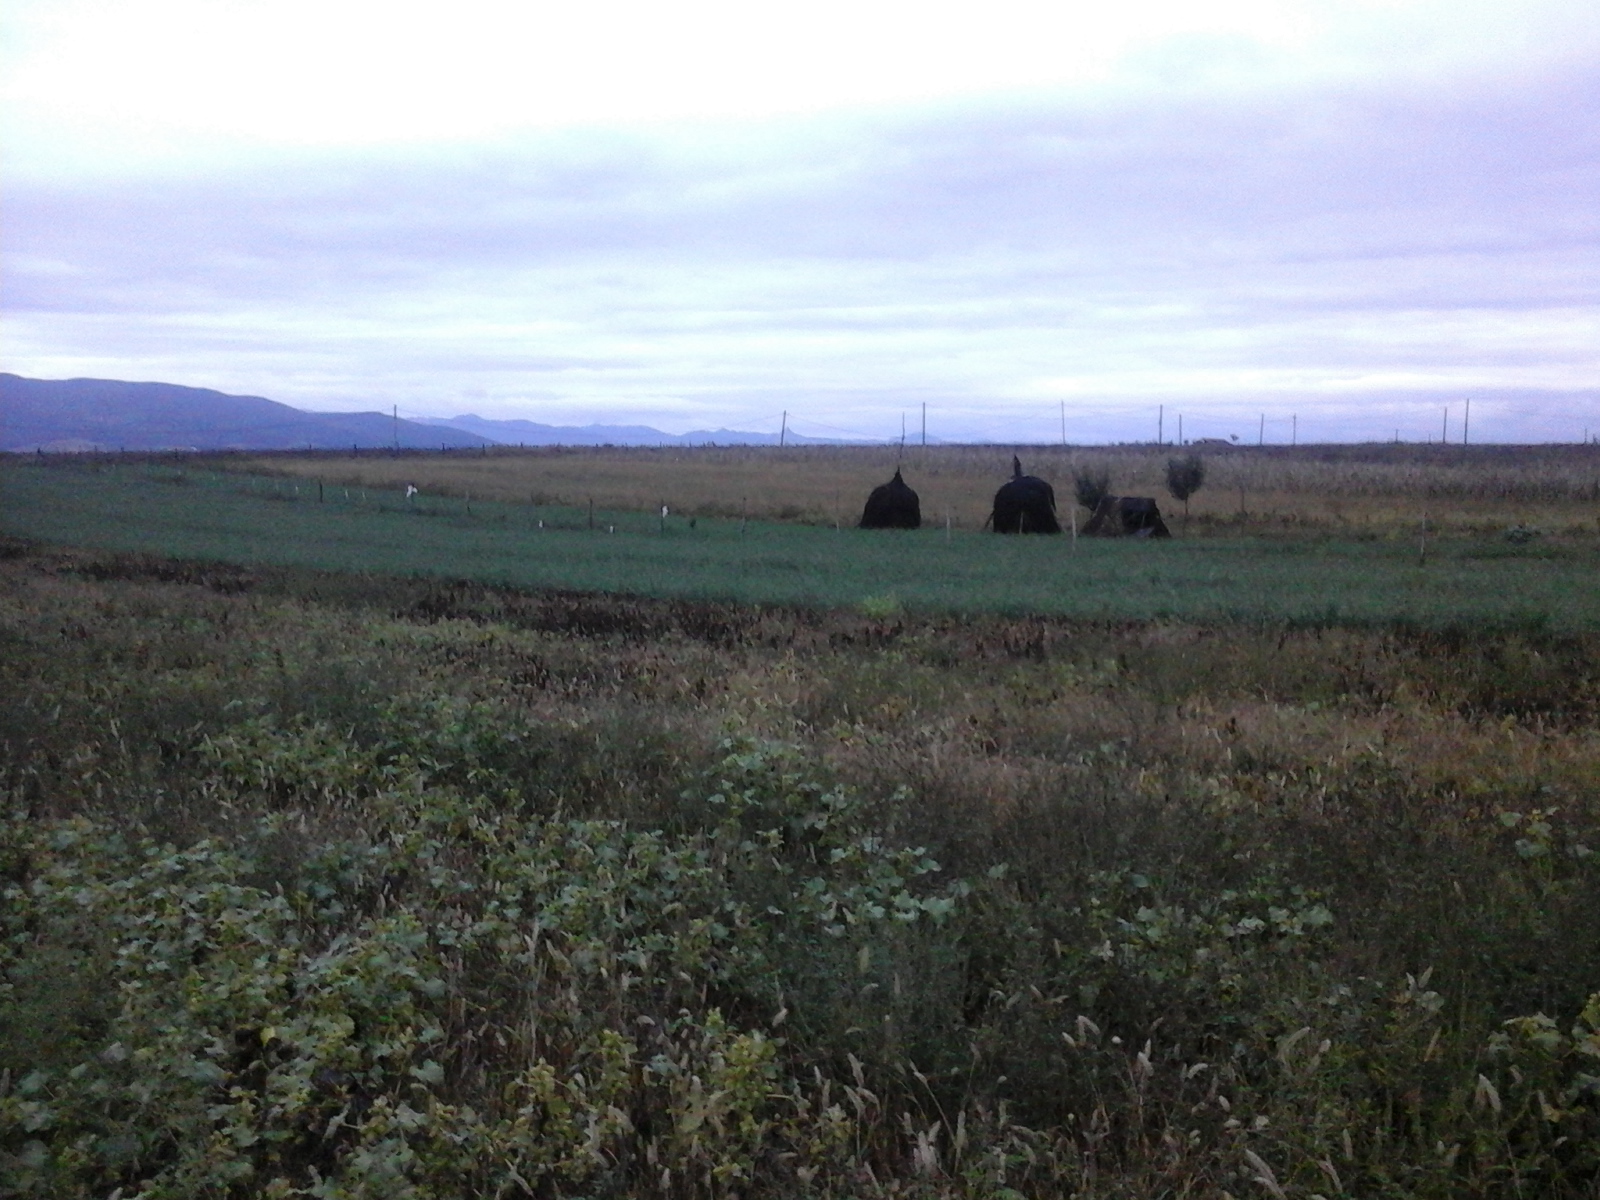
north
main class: Grassland
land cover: Spontaneously vegetated surfaces
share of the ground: > 75 %
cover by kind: herbaceous plants 100 %
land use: Fallow land
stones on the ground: < 10 %
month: September
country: RO
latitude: 46.0264
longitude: 23.5920
